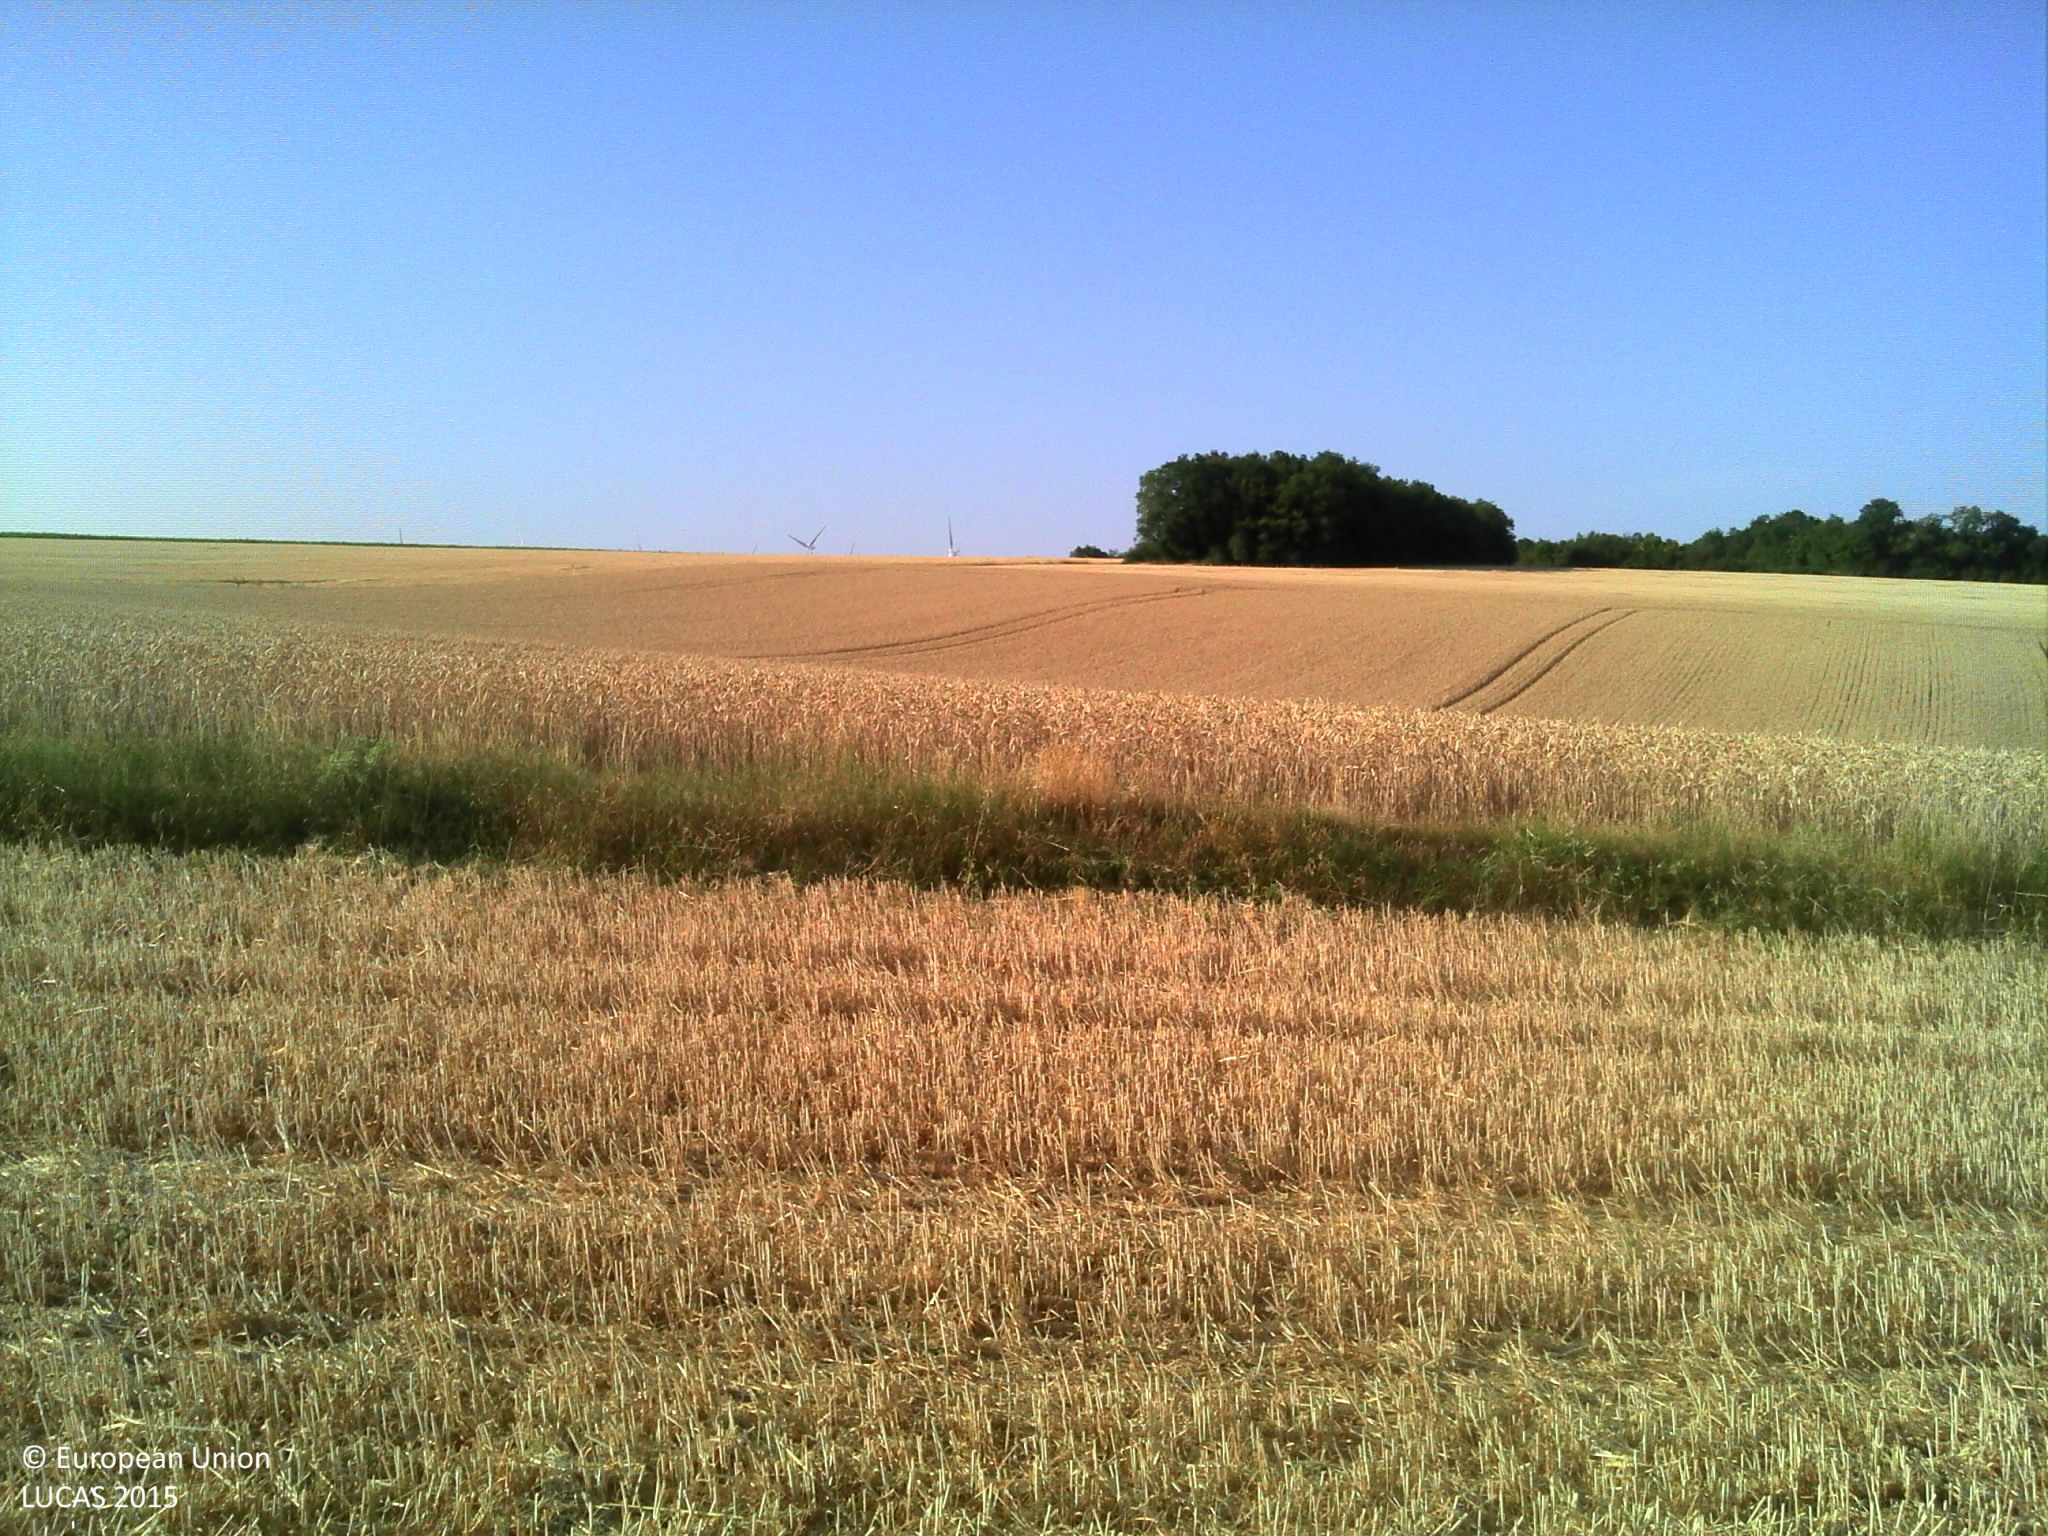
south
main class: Cropland
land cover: Common wheat
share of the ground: > 75 %
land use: Agriculture (excluding fallow land and kitchen gardens)
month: July
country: FR
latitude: 47.6859
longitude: 3.4544
